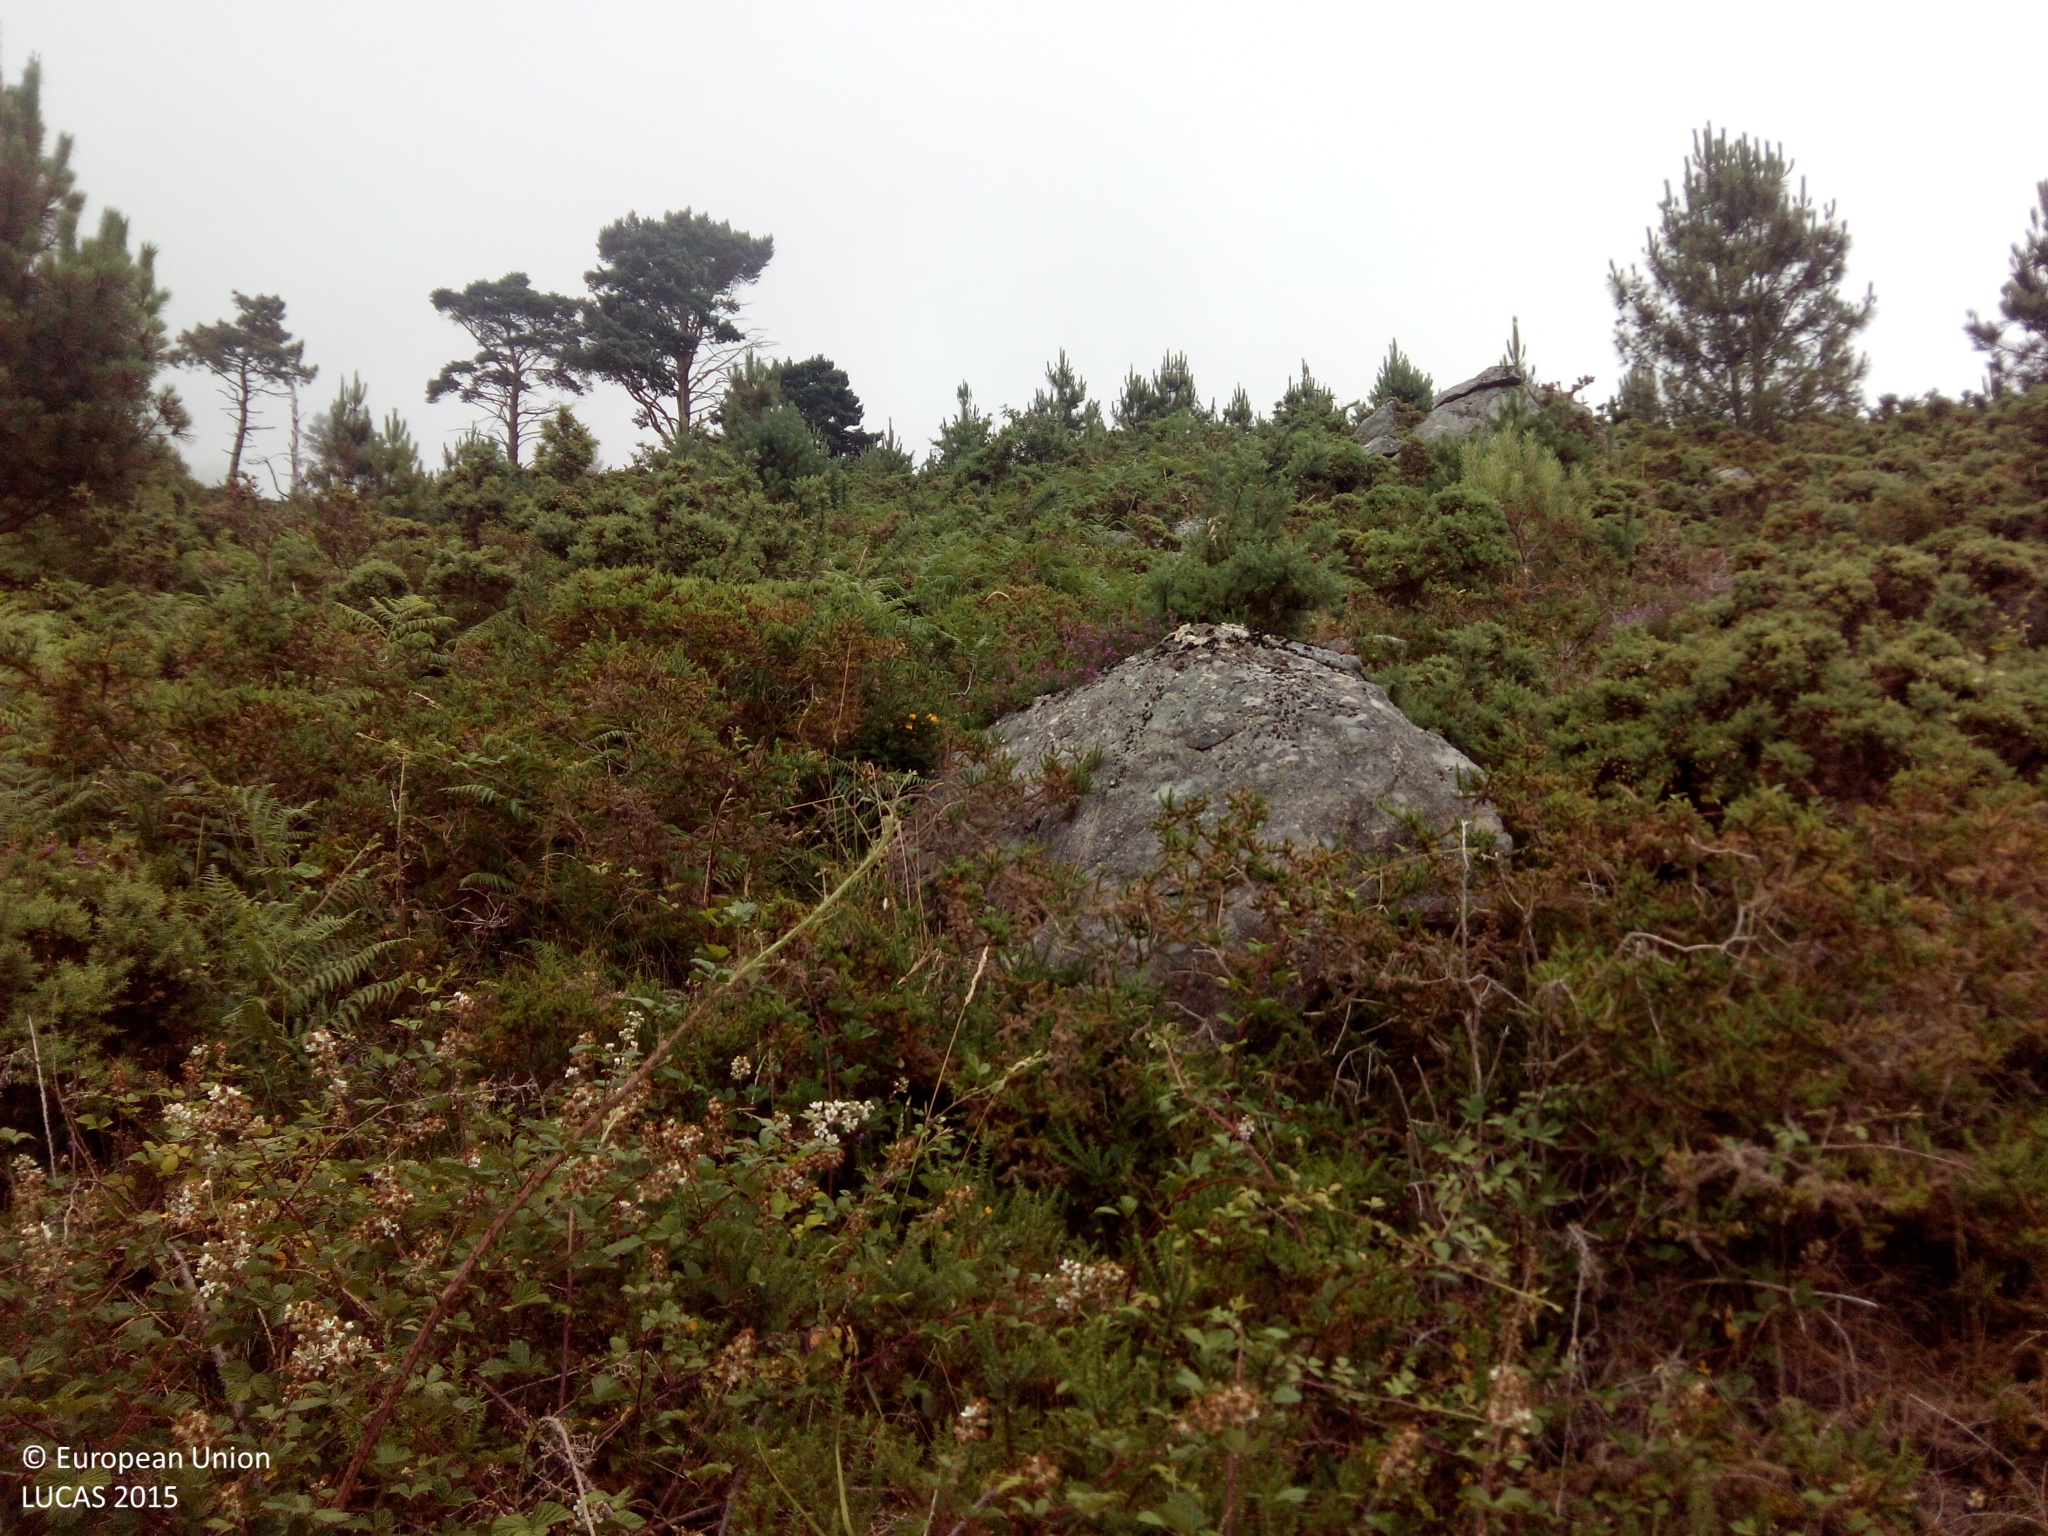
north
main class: Shrubland
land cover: Shrubland with sparse tree cover
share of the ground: > 75 %
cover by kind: shrubs 95 %, coniferous forest trees 5 %
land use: Semi-natural and natural areas not in use
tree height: < 5 m
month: July
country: ES
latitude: 42.2349
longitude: -8.2510
